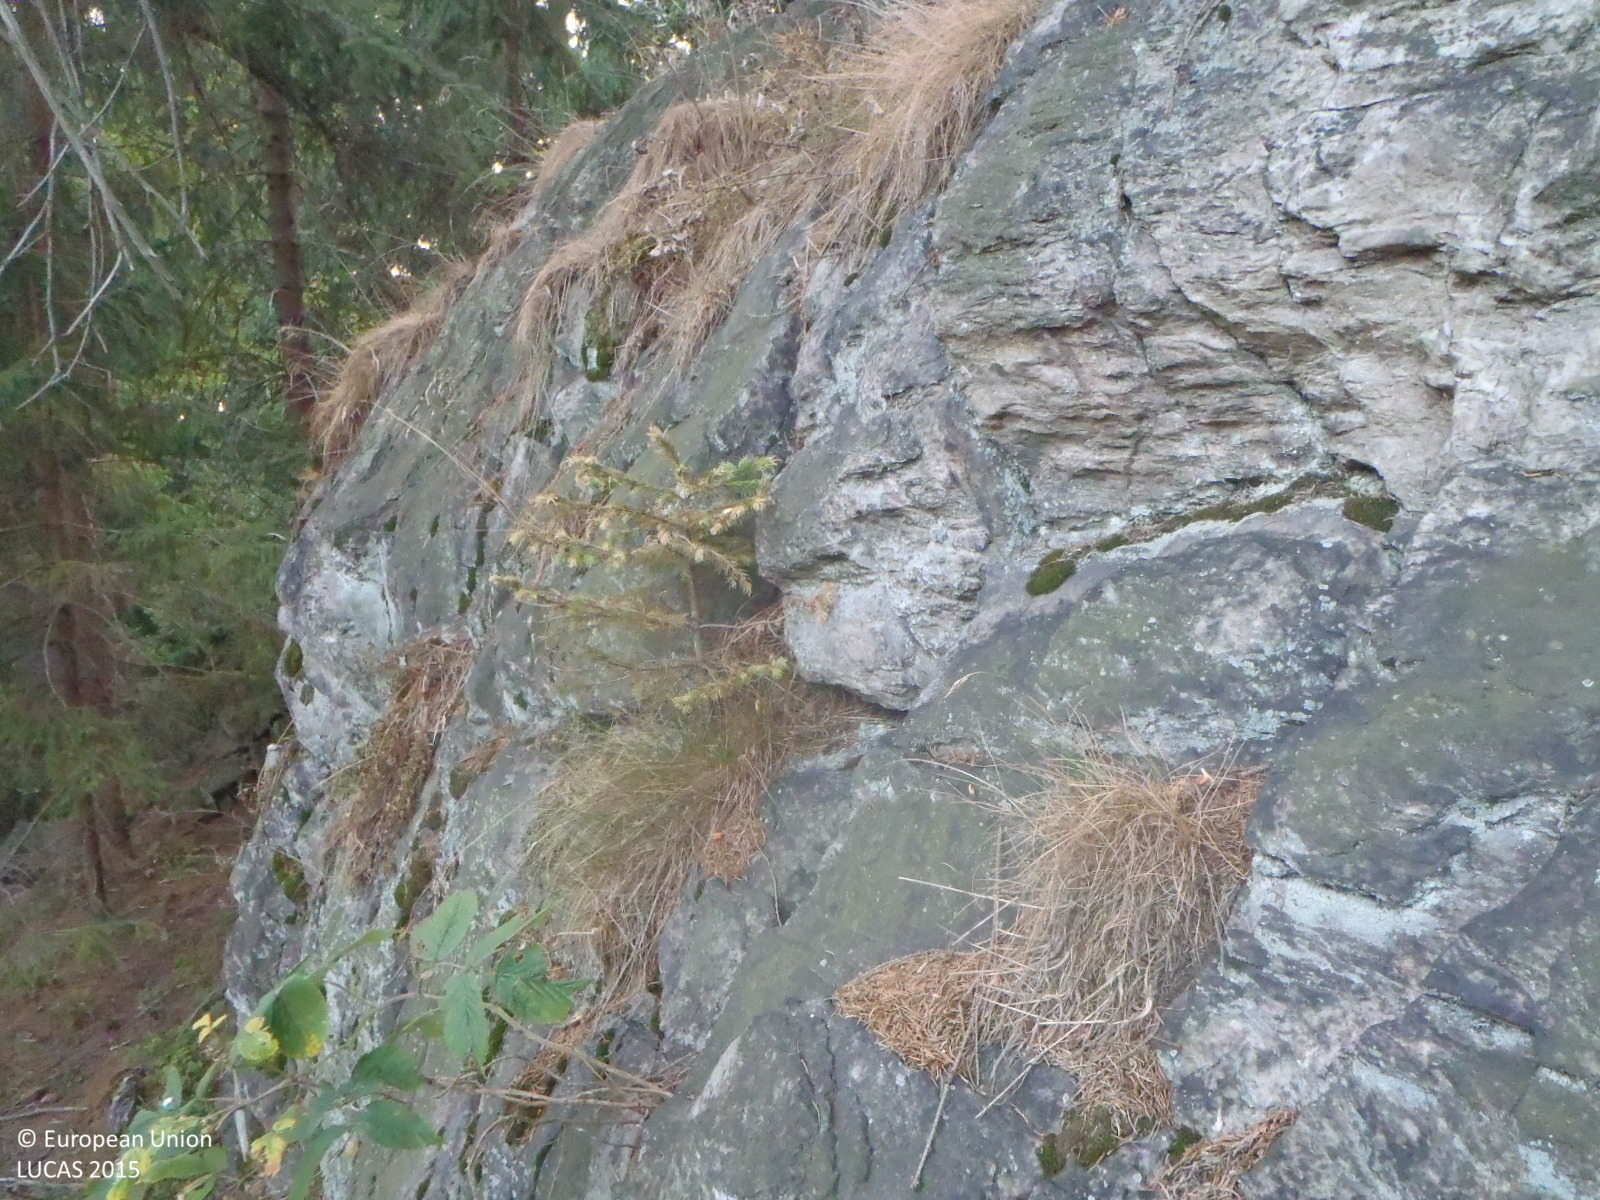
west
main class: Woodland
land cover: Spruce dominated coniferous woodland
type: hemiboreal forest and nemoral coniferous forest and mixed broadleaved-coniferous forest
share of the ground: > 75 %
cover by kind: coniferous forest trees 85 %, broadleaved forest trees 5 %, herbaceous plants 5 %
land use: Forestry
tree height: > 5 m
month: August
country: CZ
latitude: 50.7242
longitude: 14.9750
